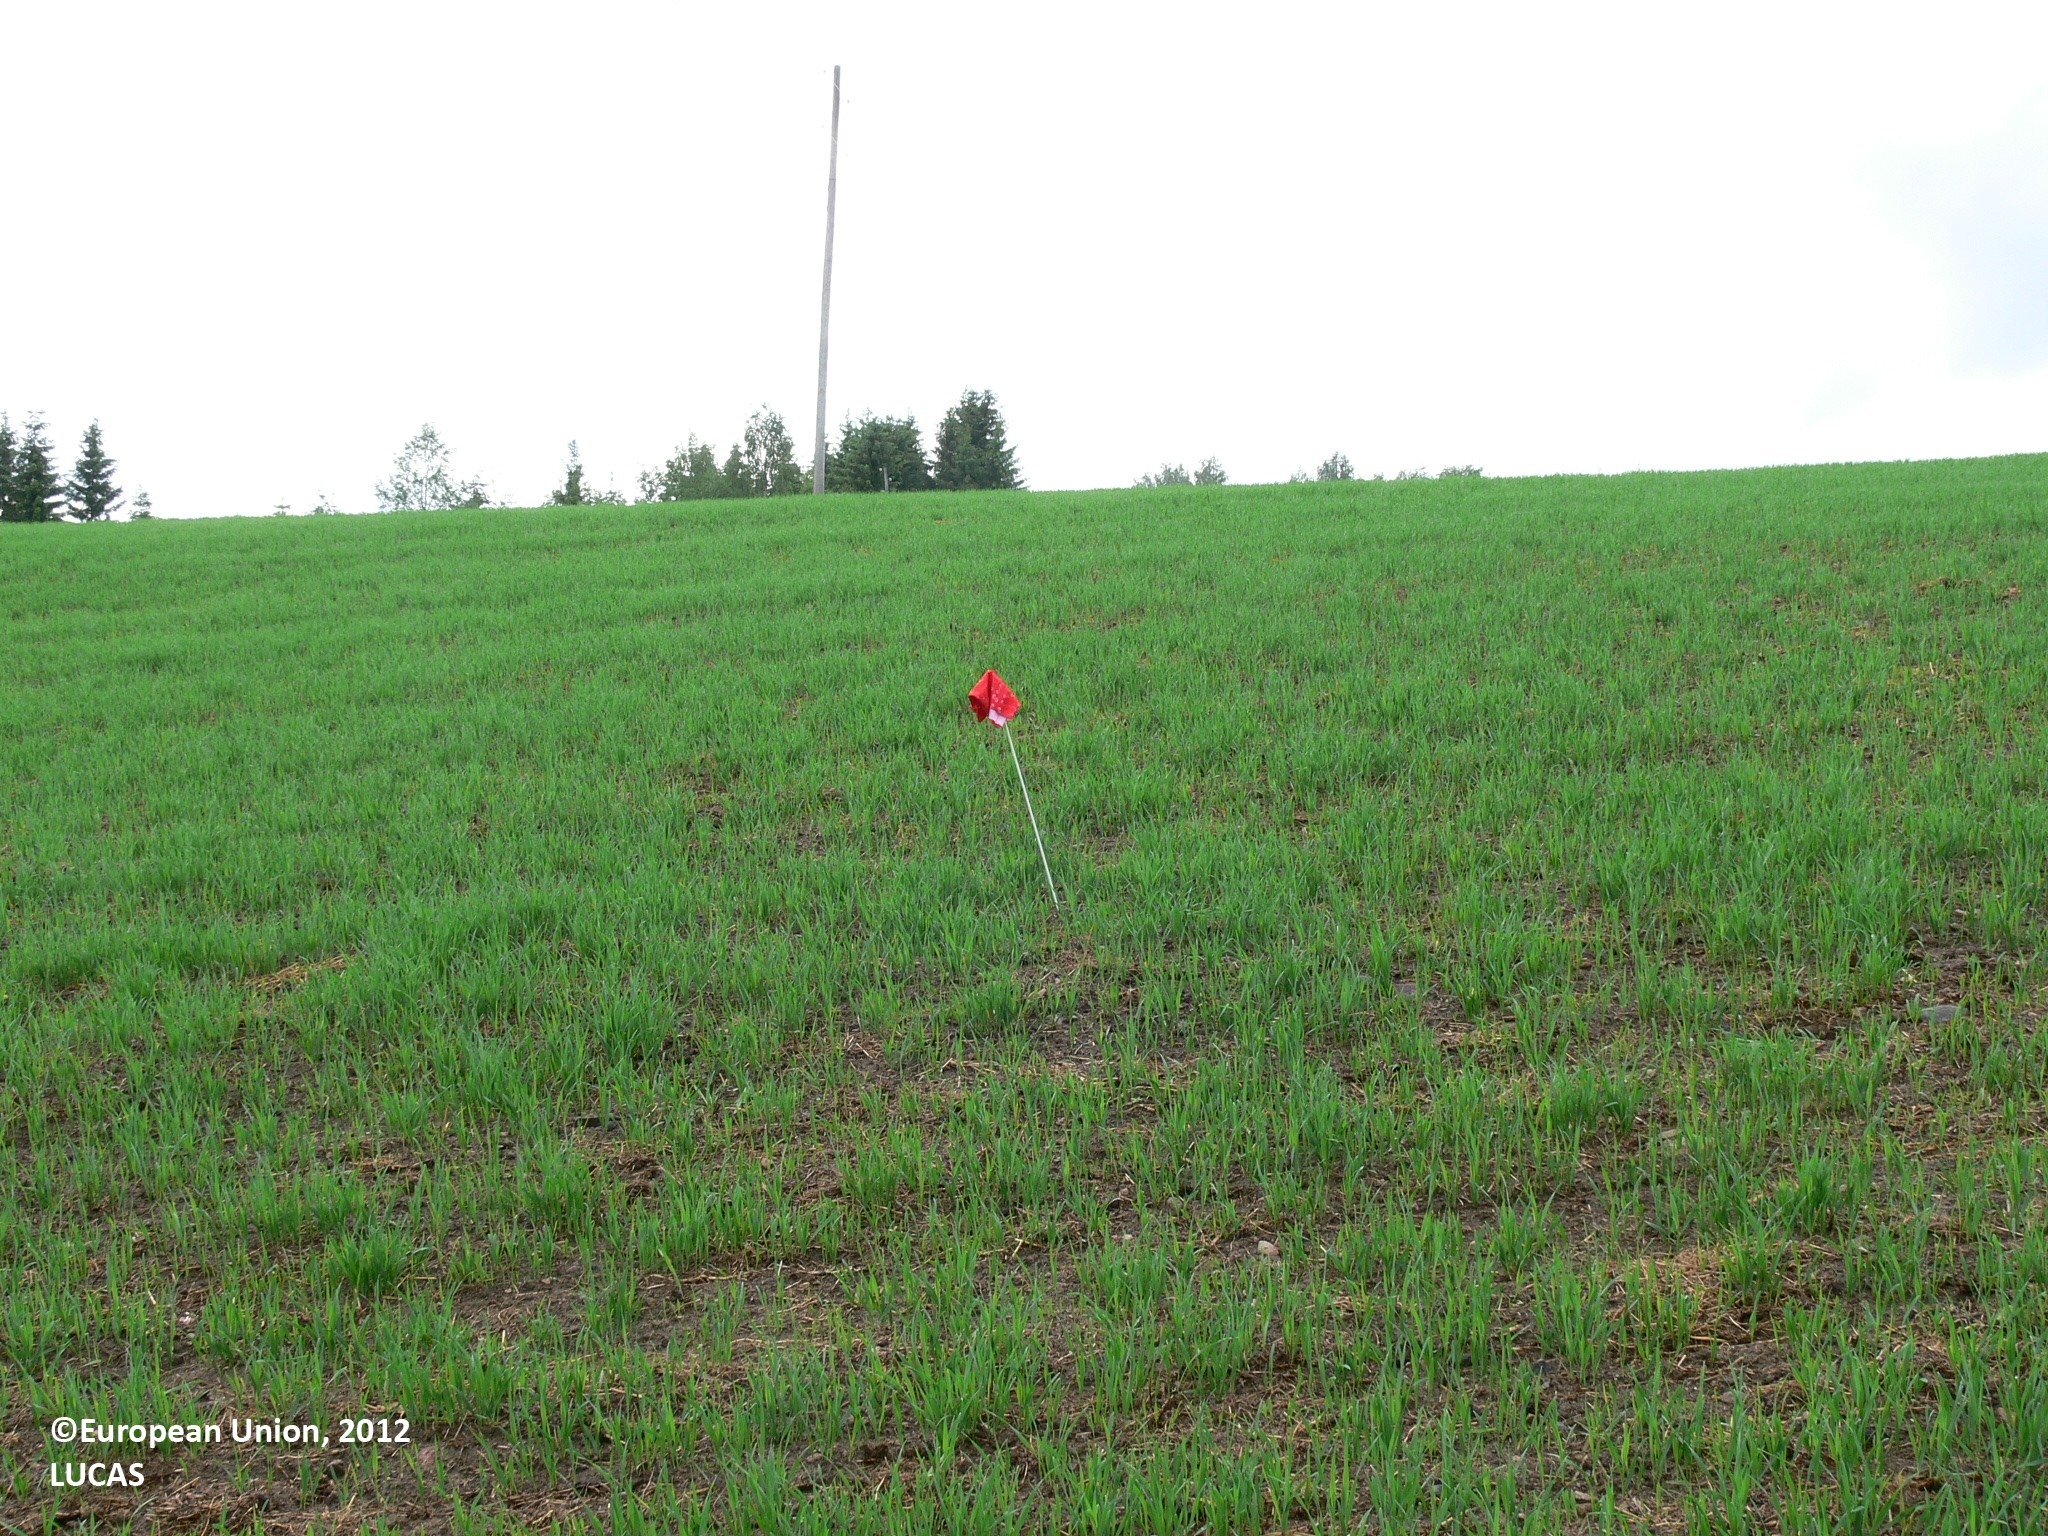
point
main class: Cropland
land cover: Oats
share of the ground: 25 - 50 %
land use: Agriculture (excluding fallow land and kitchen gardens)
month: June
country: FI
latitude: 62.4221
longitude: 30.4365
